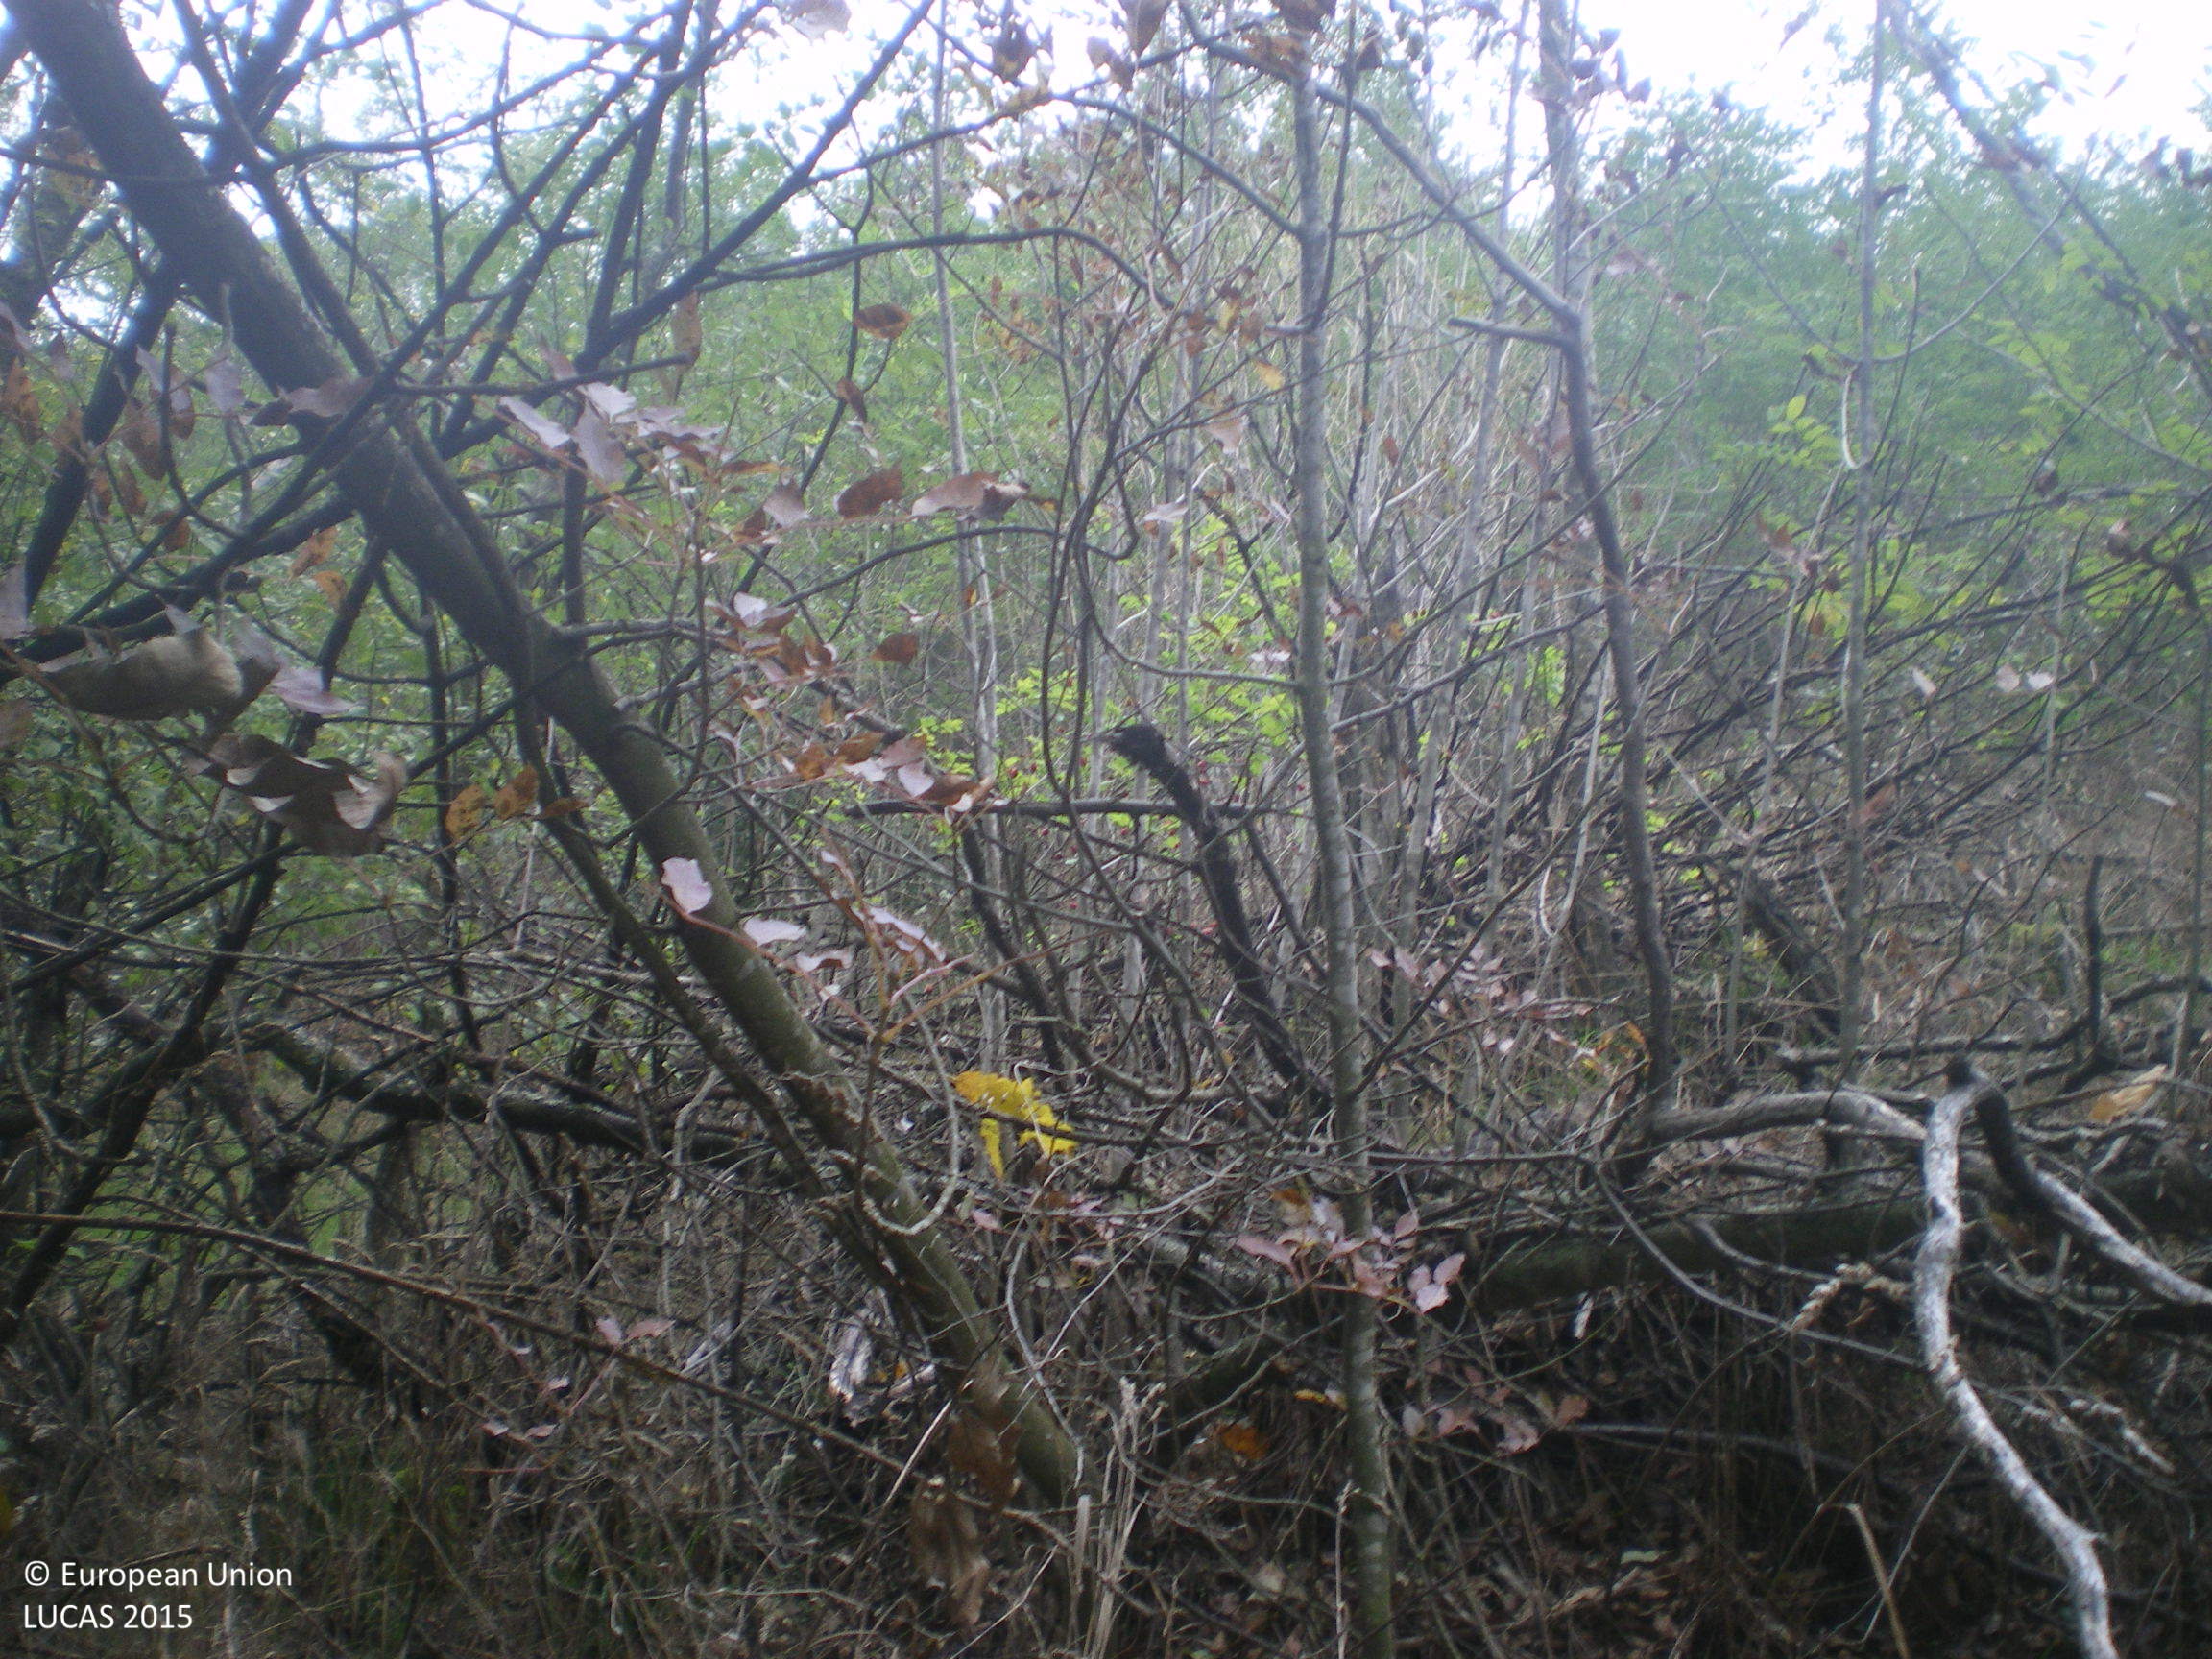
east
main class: Woodland
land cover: Other mixed woodland
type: hemiboreal forest and nemoral coniferous forest and mixed broadleaved-coniferous forest
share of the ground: > 75 %
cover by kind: coniferous forest trees 65 %, broadleaved forest trees 25 %, shrubs 10 %
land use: Forestry
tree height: > 5 m
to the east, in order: Other mixed woodland; Broadleaved woodland; Pine dominated mixed woodland; Broadleaved woodland
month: October
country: BG
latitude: 42.6758
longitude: 25.6585
